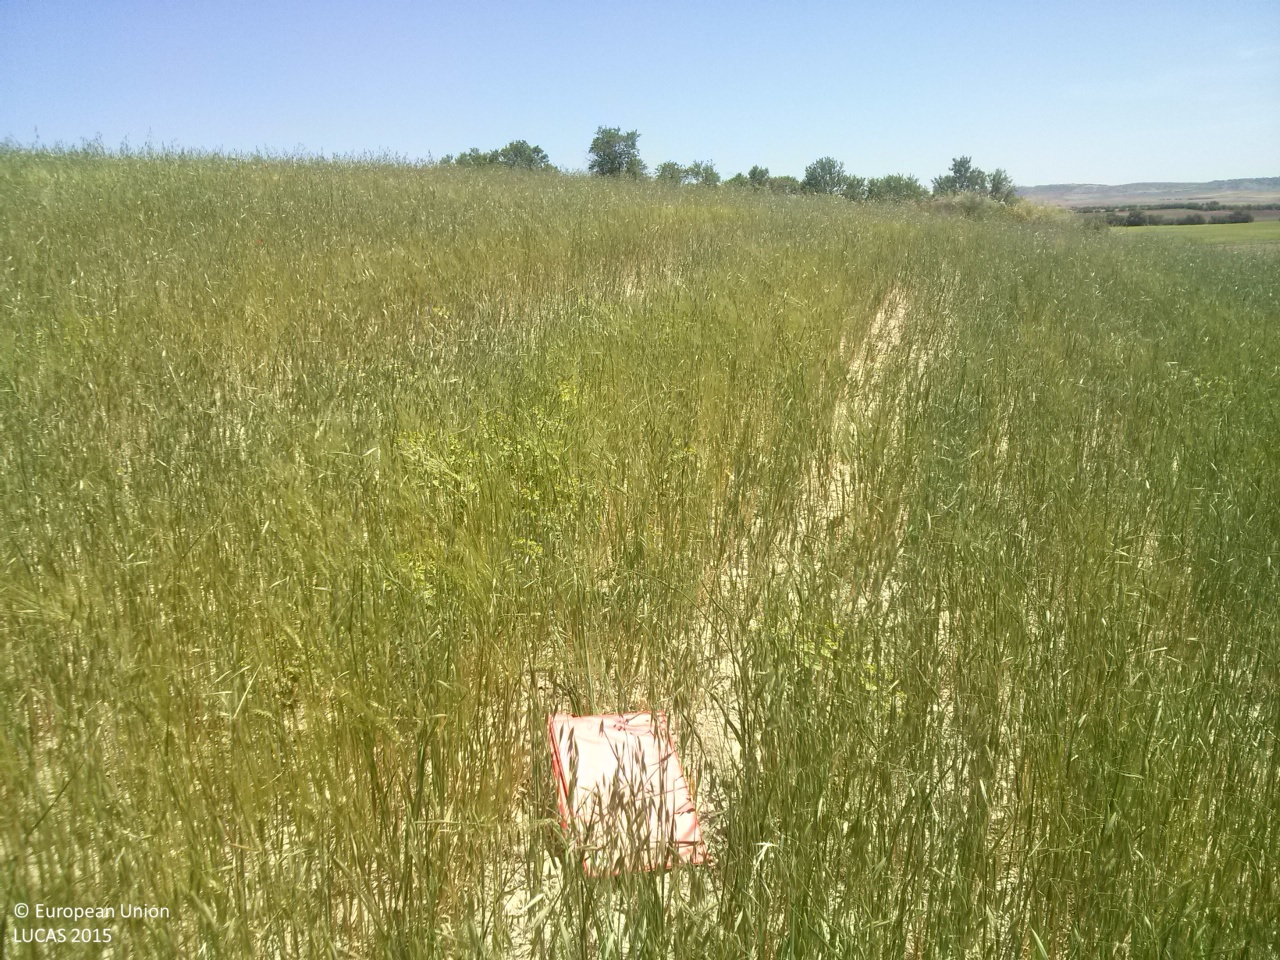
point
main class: Cropland
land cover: Mixed cereals for fodder
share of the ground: > 75 %
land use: Agriculture (excluding fallow land and kitchen gardens)
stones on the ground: < 10 %
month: May
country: ES
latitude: 39.9867
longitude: -2.7033
